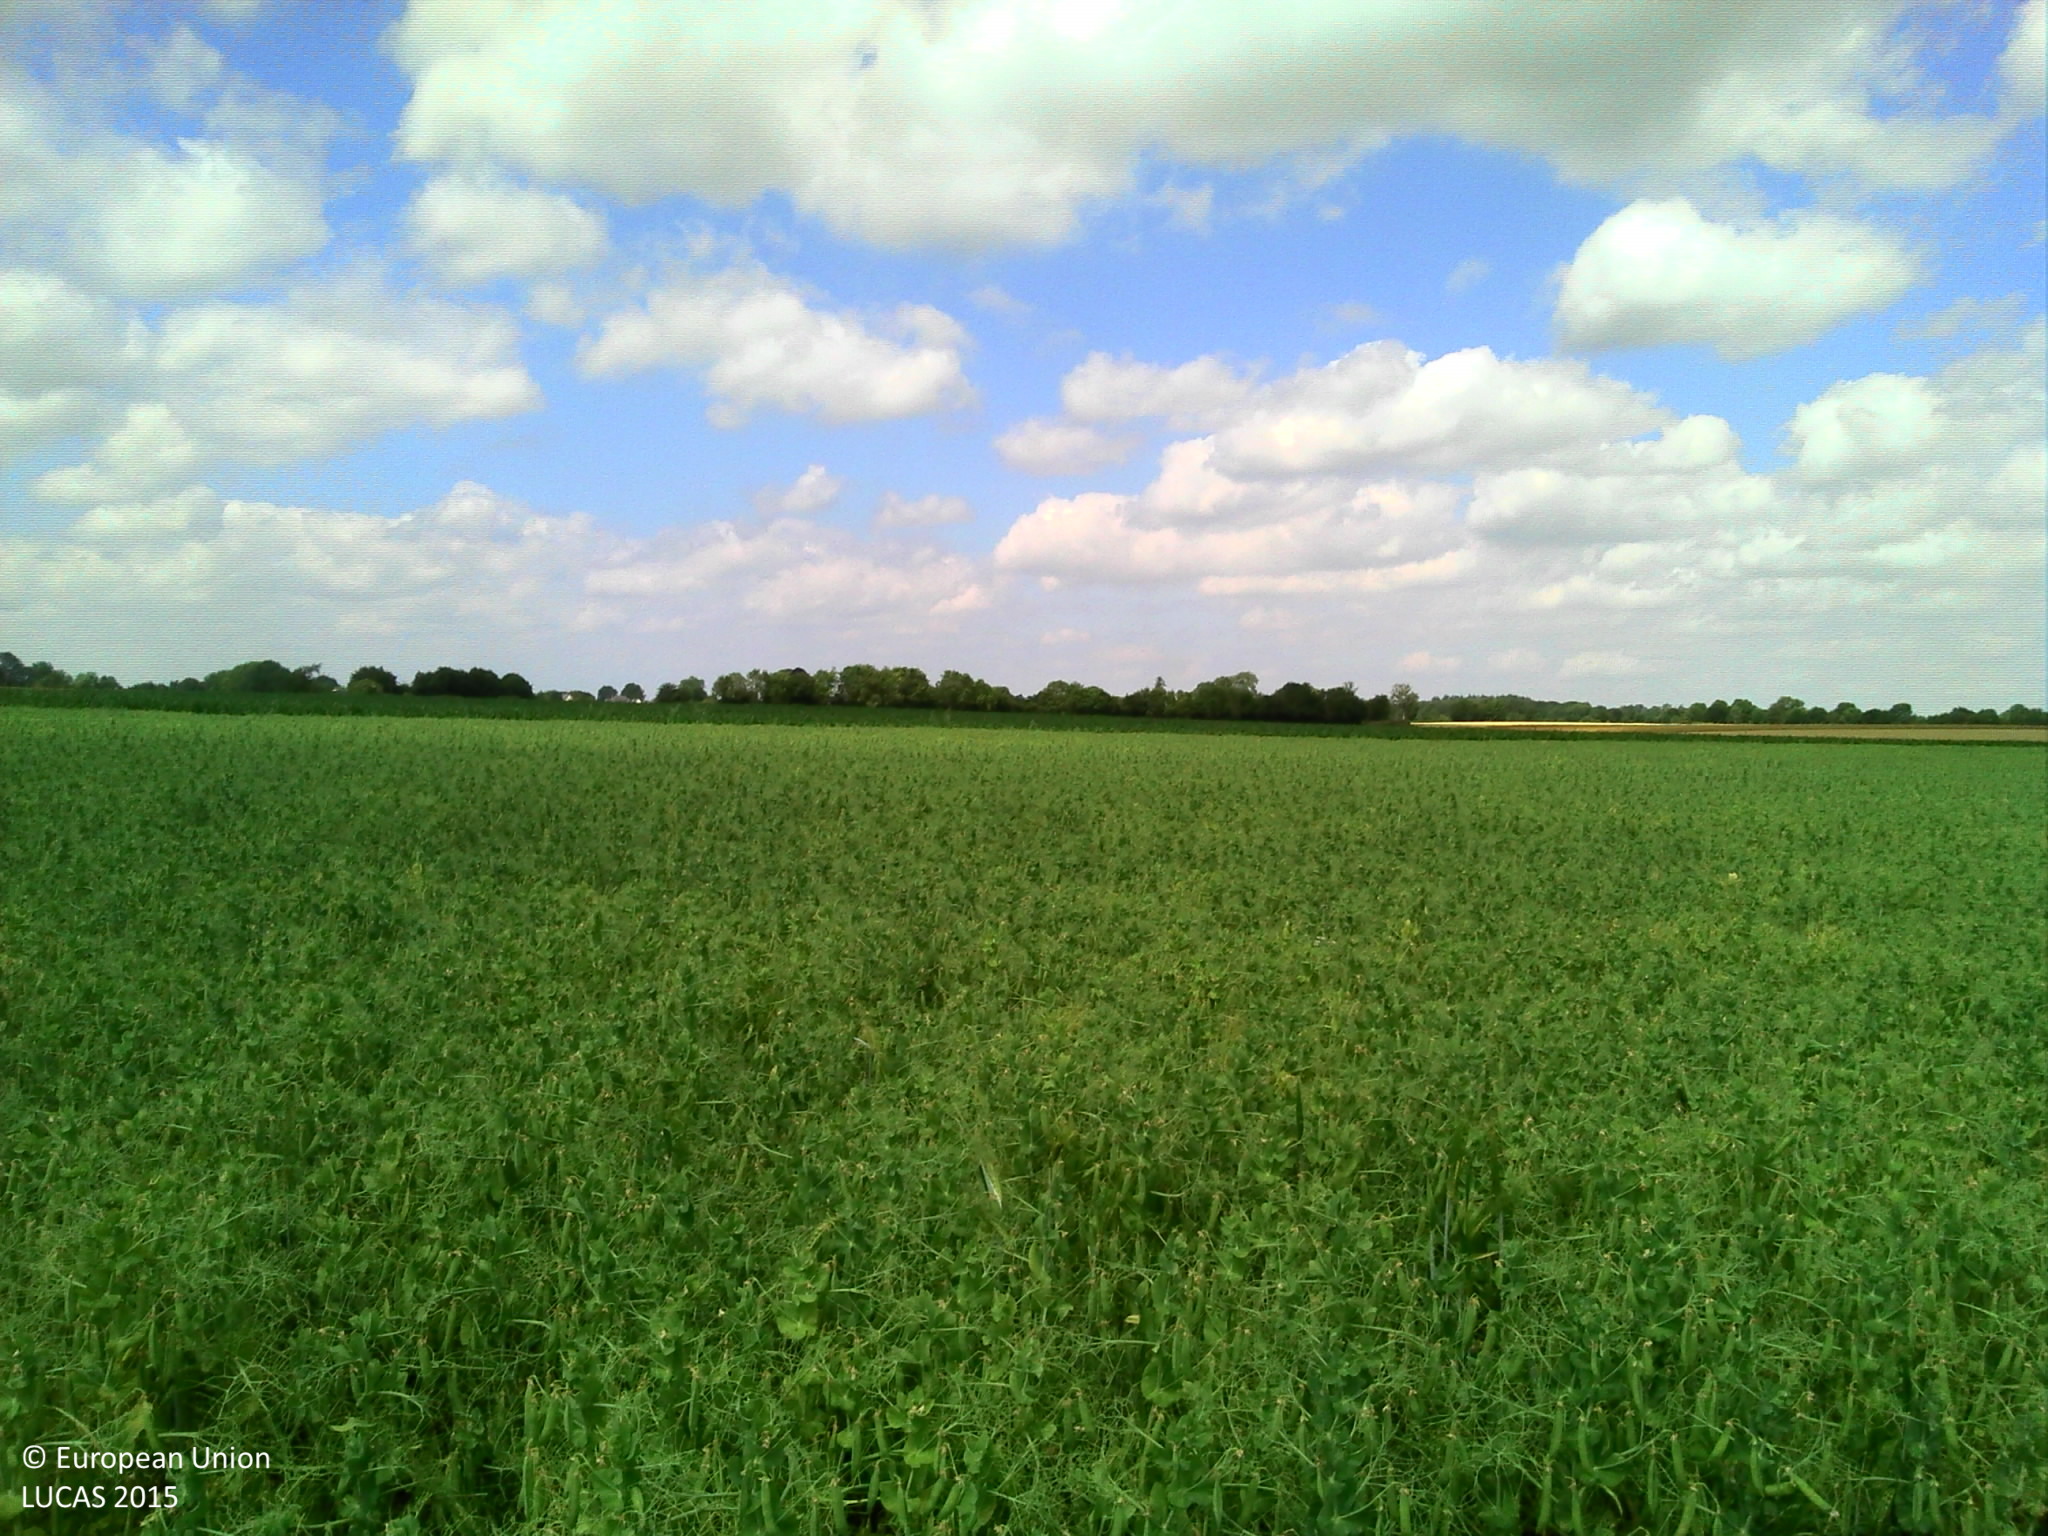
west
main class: Cropland
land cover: Dry pulses
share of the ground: > 75 %
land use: Agriculture (excluding fallow land and kitchen gardens)
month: July
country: FR
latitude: 49.6513
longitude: 1.7697
